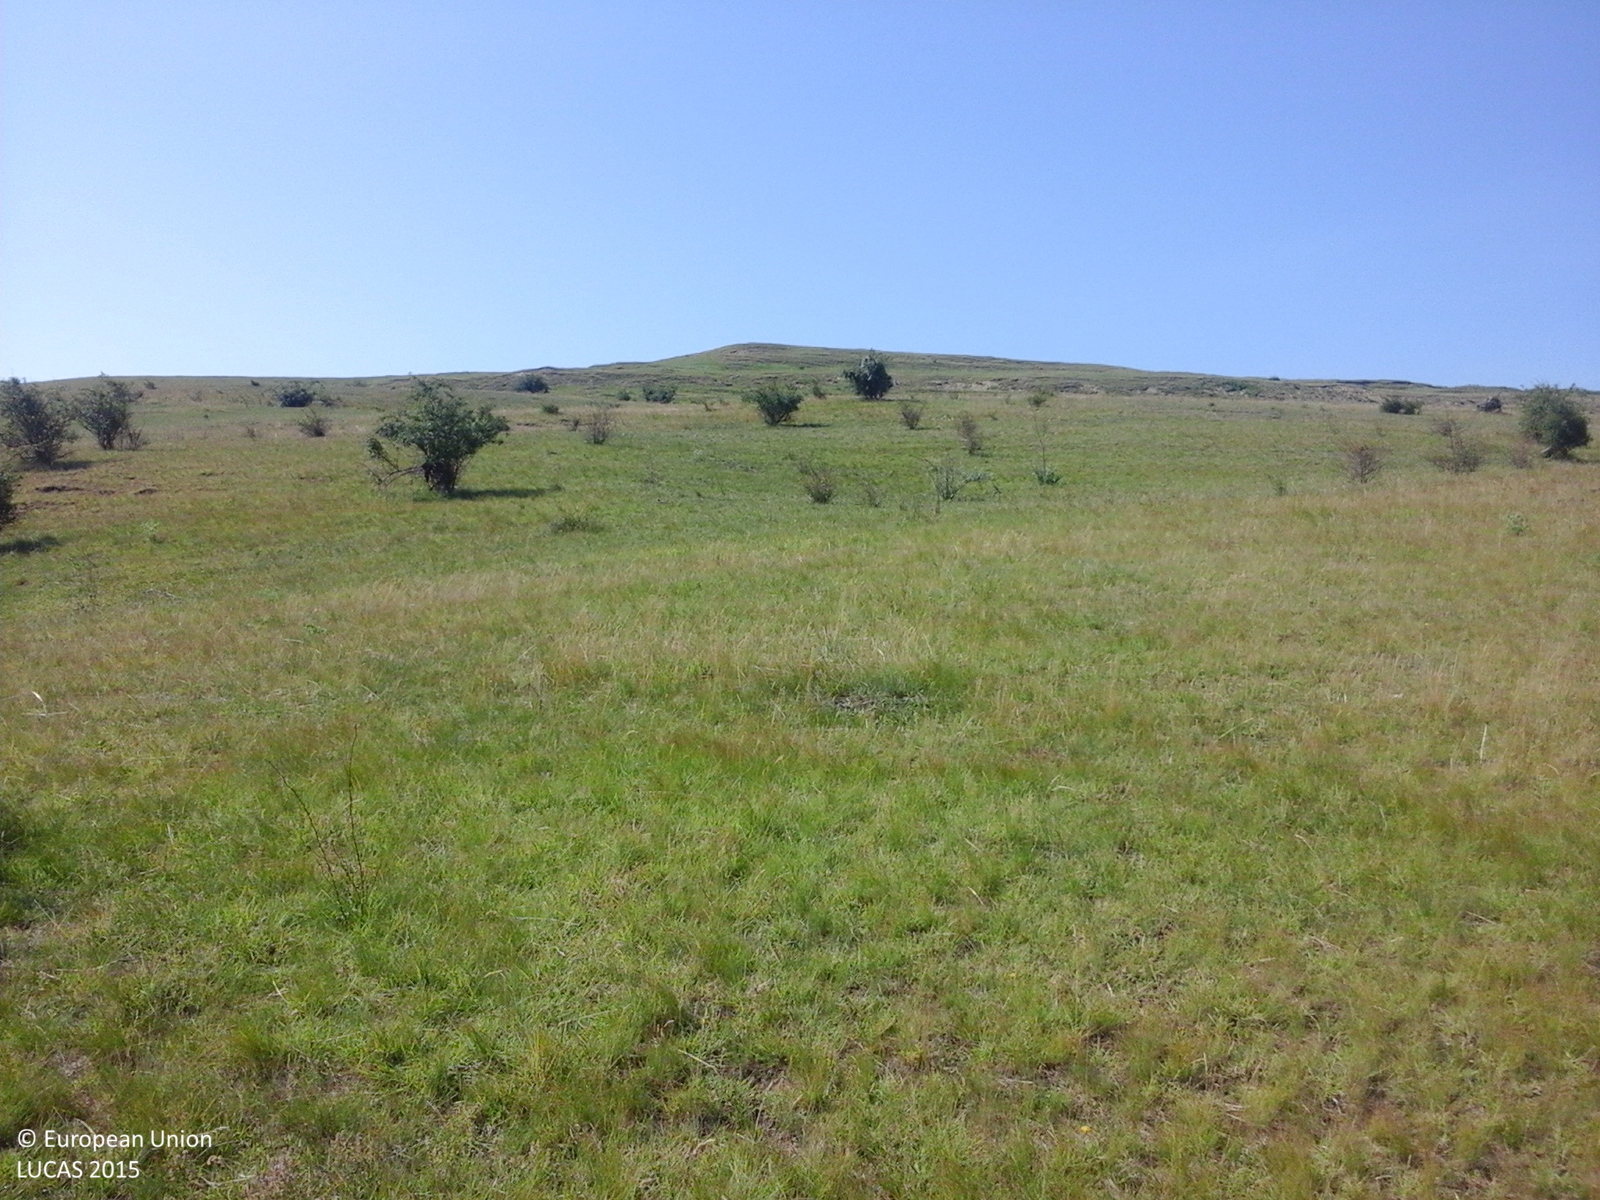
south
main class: Grassland
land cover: Grassland with sparse tree/shrub cover
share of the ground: > 75 %
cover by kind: herbaceous plants 85 %, shrubs 10 %, broadleaved forest trees 5 %
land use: Agriculture (excluding fallow land and kitchen gardens)
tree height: < 5 m
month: June
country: RO
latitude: 47.6854
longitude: 27.2026
